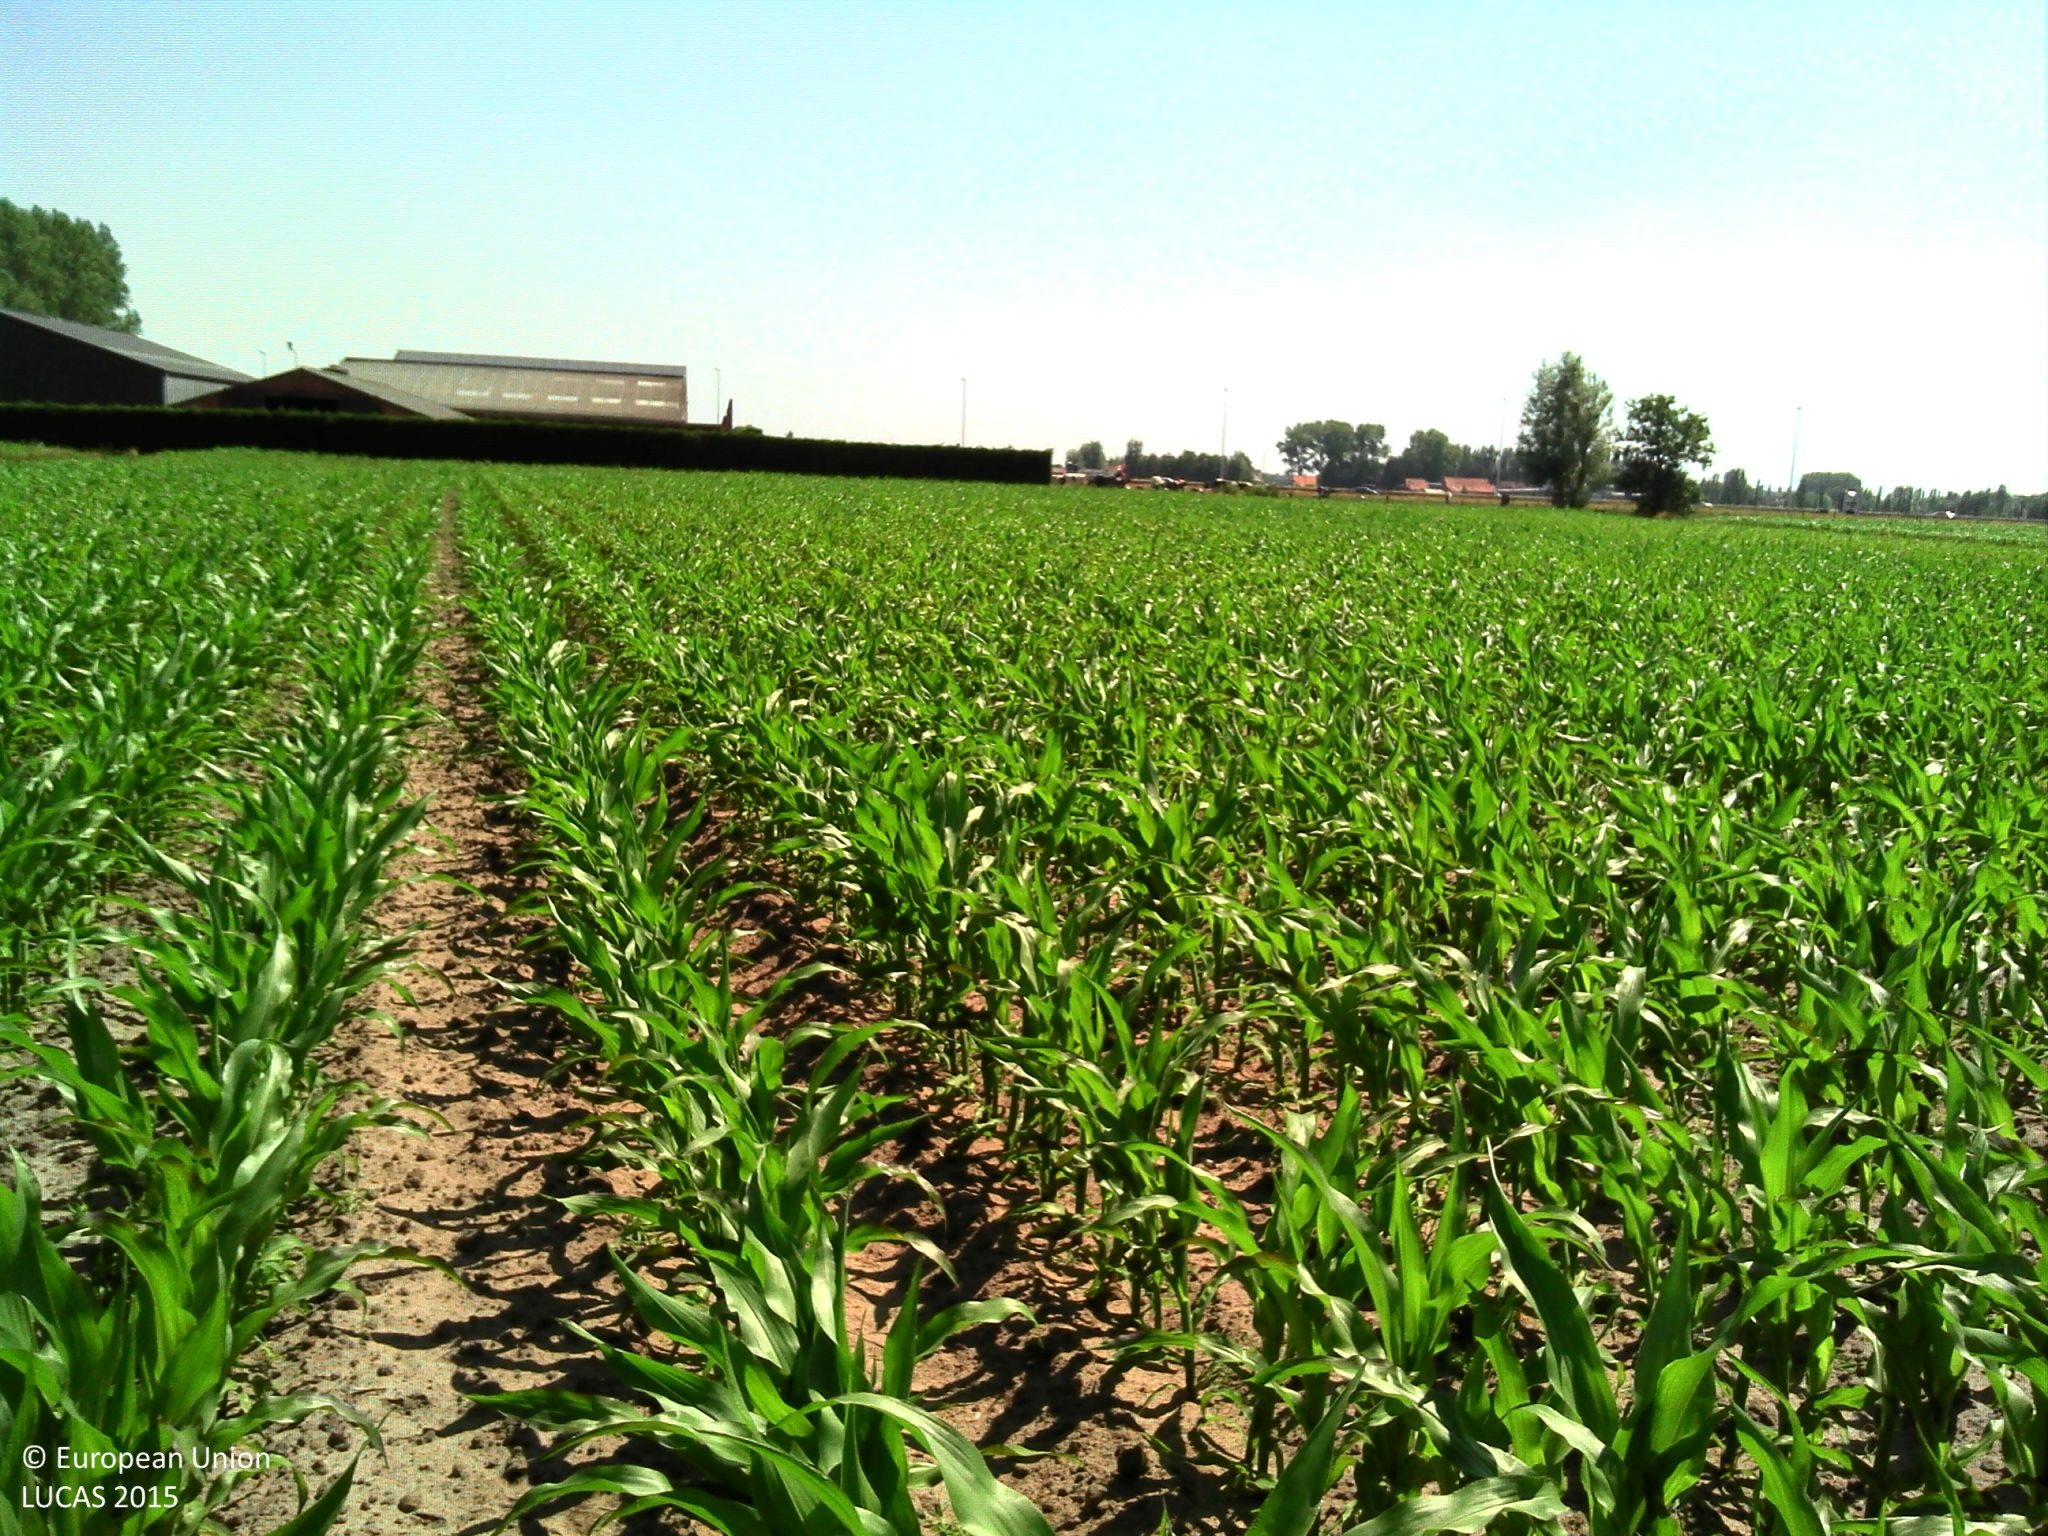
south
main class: Cropland
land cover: Maize
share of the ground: > 75 %
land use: Agriculture (excluding fallow land and kitchen gardens)
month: June
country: BE
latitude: 51.2157
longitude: 3.6506
